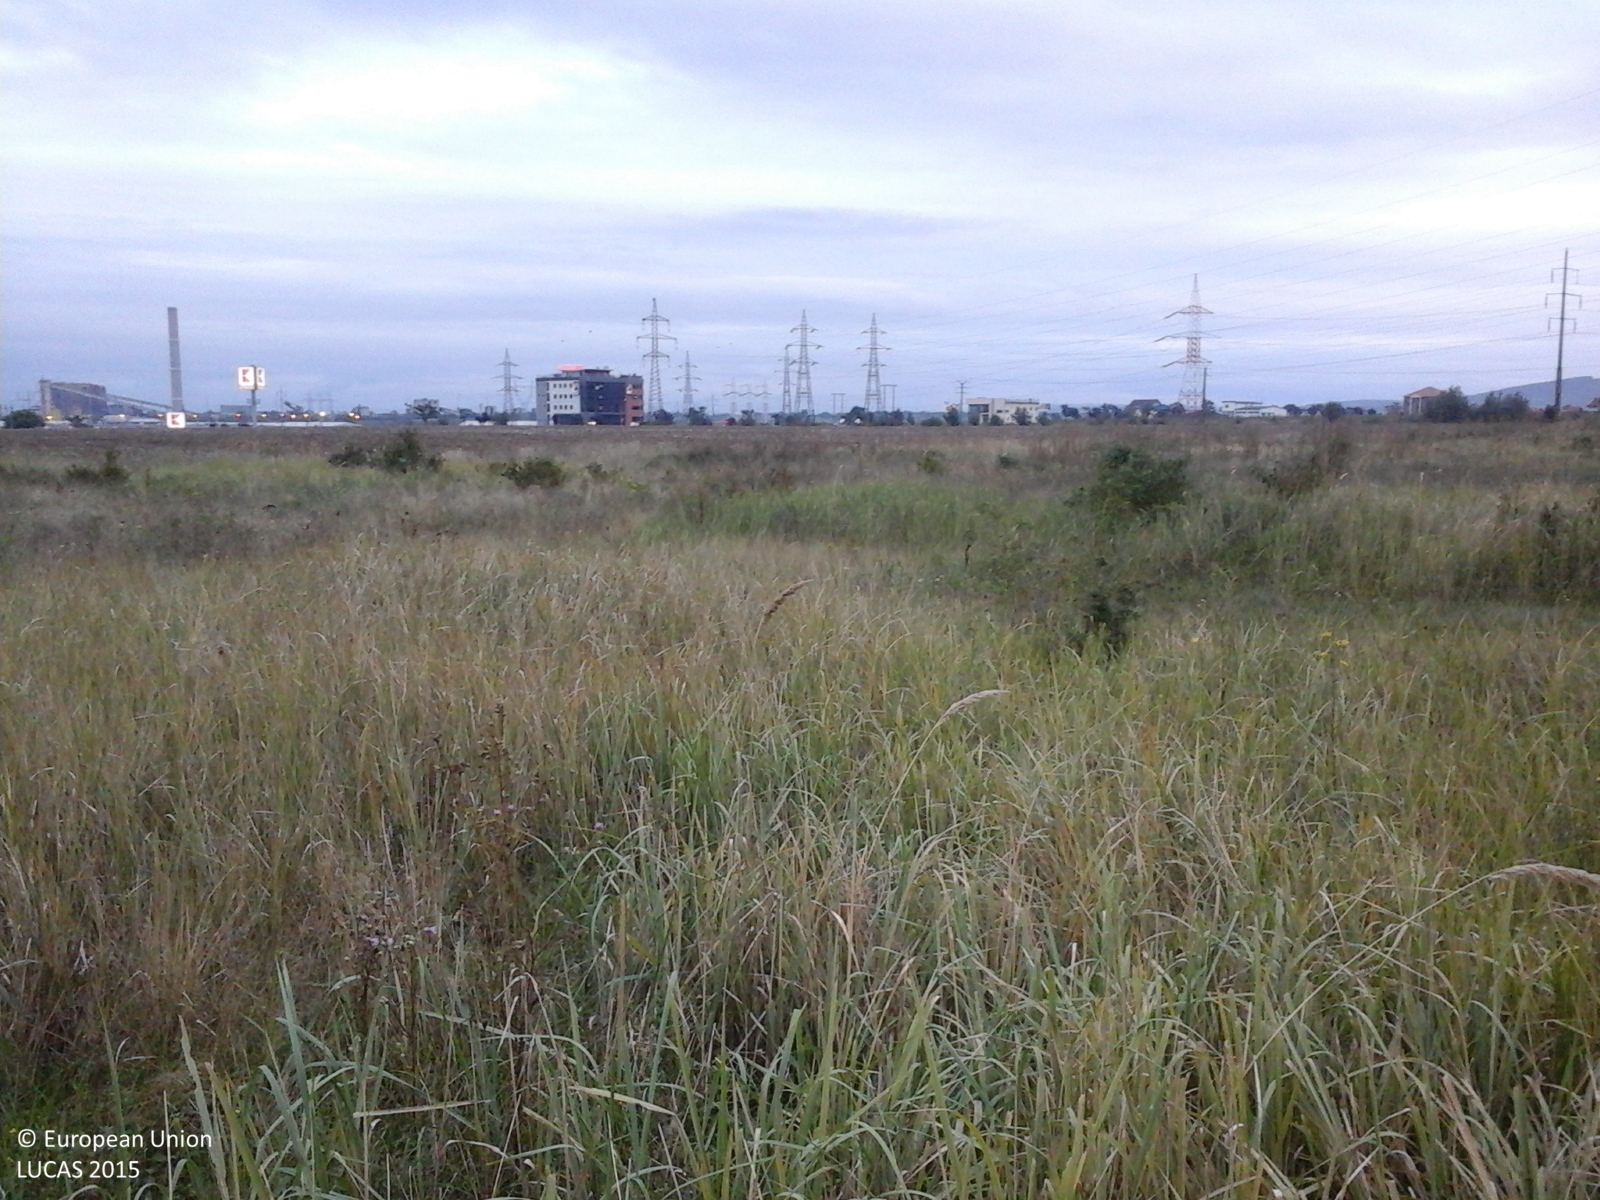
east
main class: Grassland
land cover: Grassland with sparse tree/shrub cover
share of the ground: > 75 %
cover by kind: herbaceous plants 85 %, shrubs 10 %, broadleaved forest trees 5 %
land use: Agriculture (excluding fallow land and kitchen gardens)
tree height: < 5 m
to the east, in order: Grassland with sparse tree/shrub cover; Rape and turnip rape
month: September
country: RO
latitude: 47.0247
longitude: 21.9538
